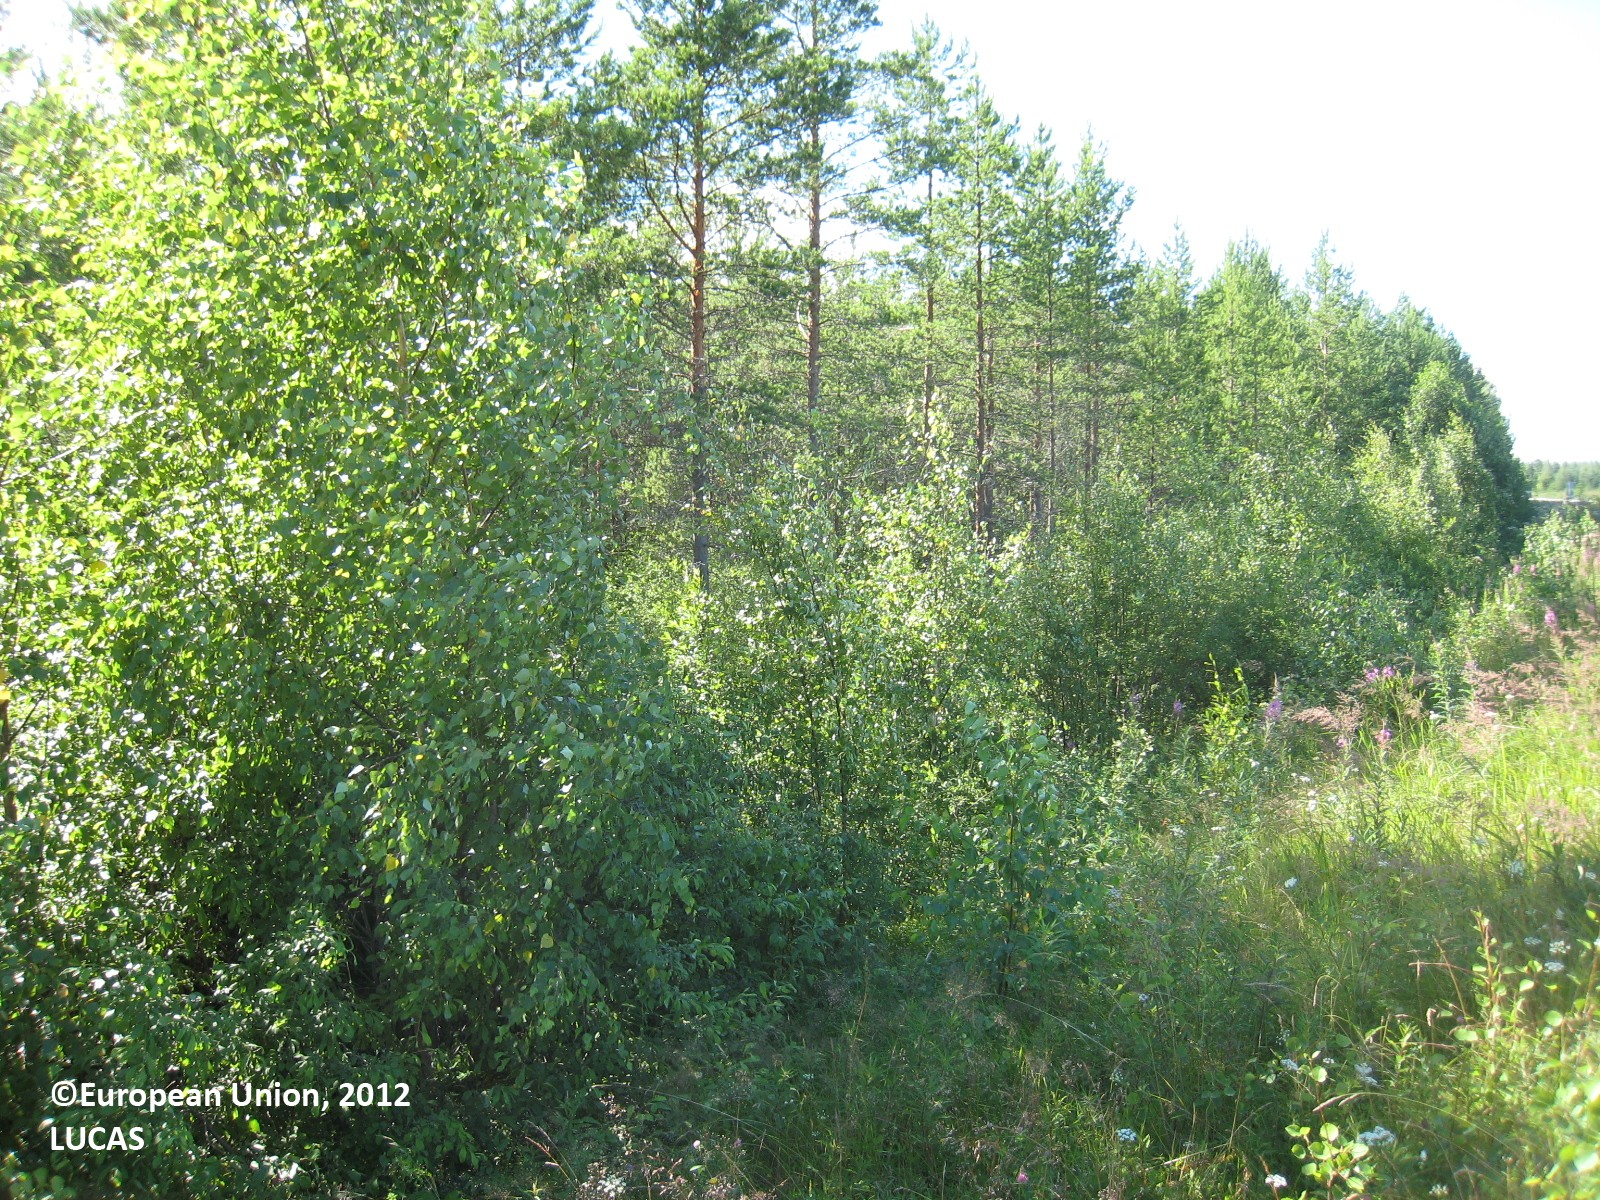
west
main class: Grassland
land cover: Grassland with sparse tree/shrub cover
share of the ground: > 75 %
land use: Road transport
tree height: < 5 m
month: July
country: FI
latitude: 62.9545
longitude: 26.7986
